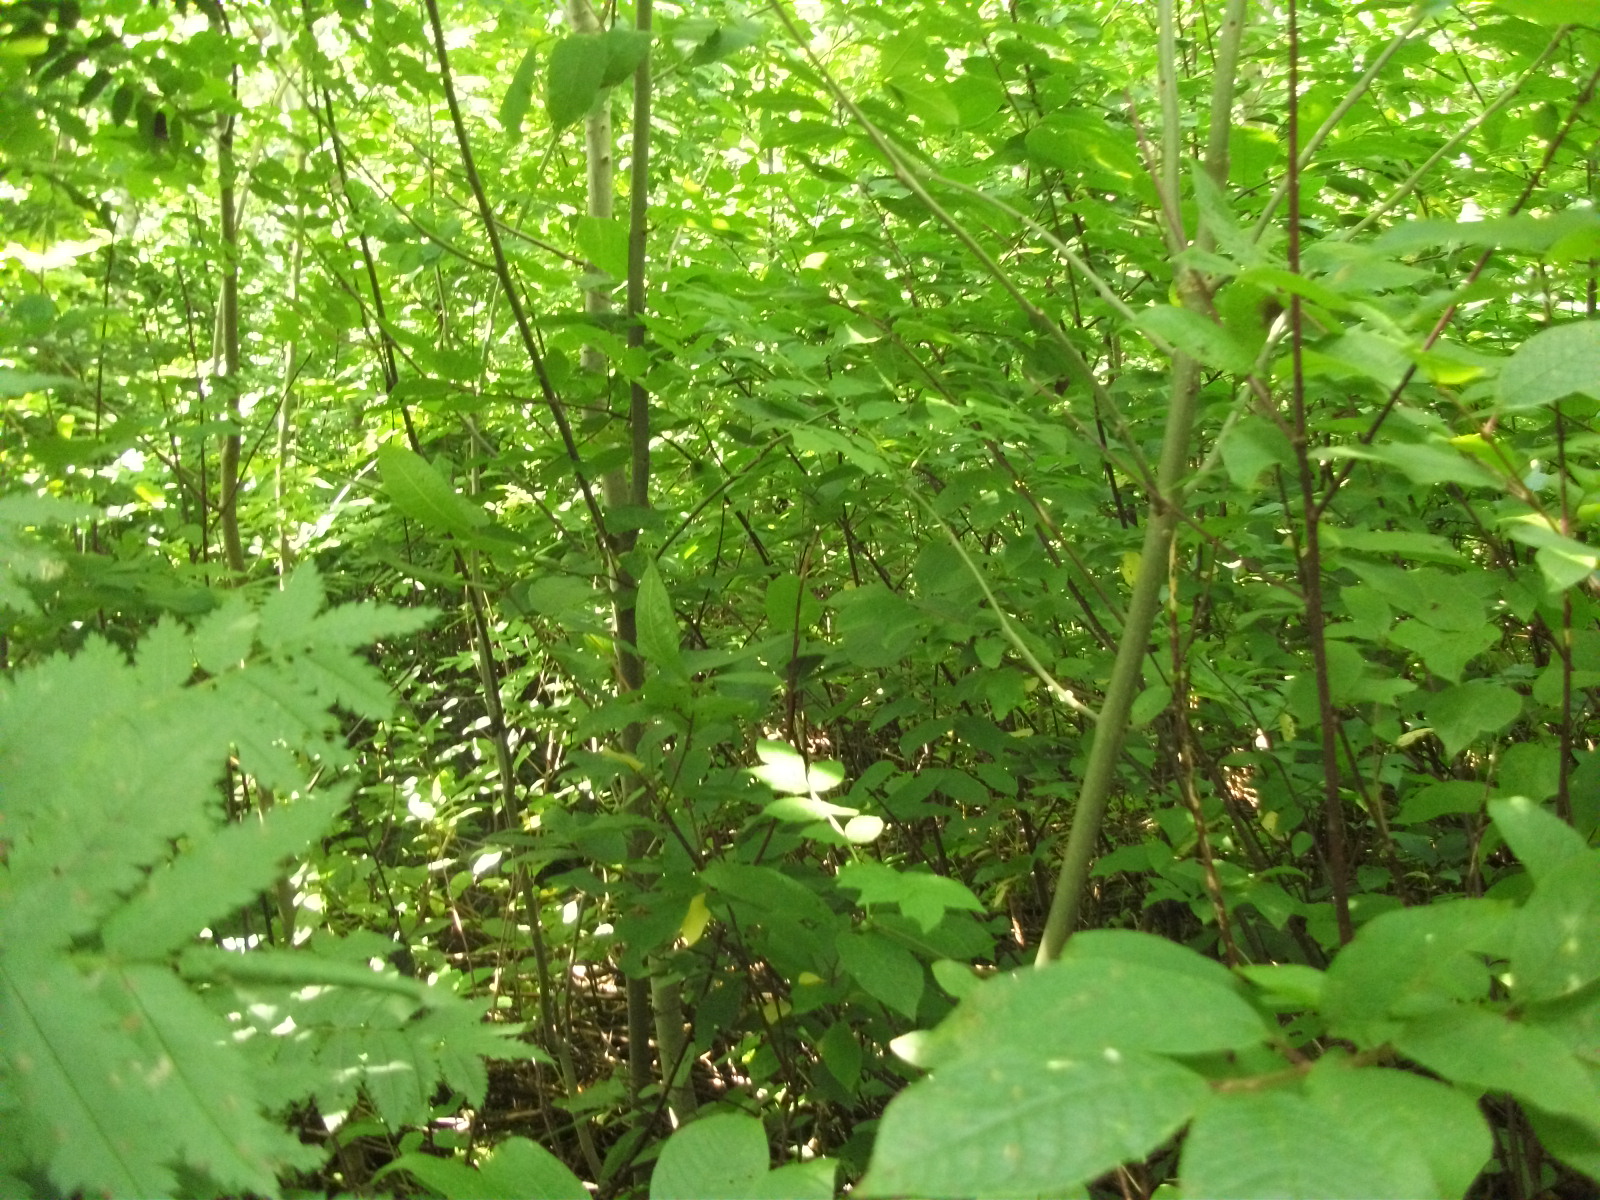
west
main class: Woodland
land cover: Broadleaved woodland
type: non-riverine alder, birch or aspen forest
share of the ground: > 75 %
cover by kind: broadleaved forest trees 100 %
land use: Forestry
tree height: > 5 m
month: July
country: LV
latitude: 57.0295
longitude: 26.3021
